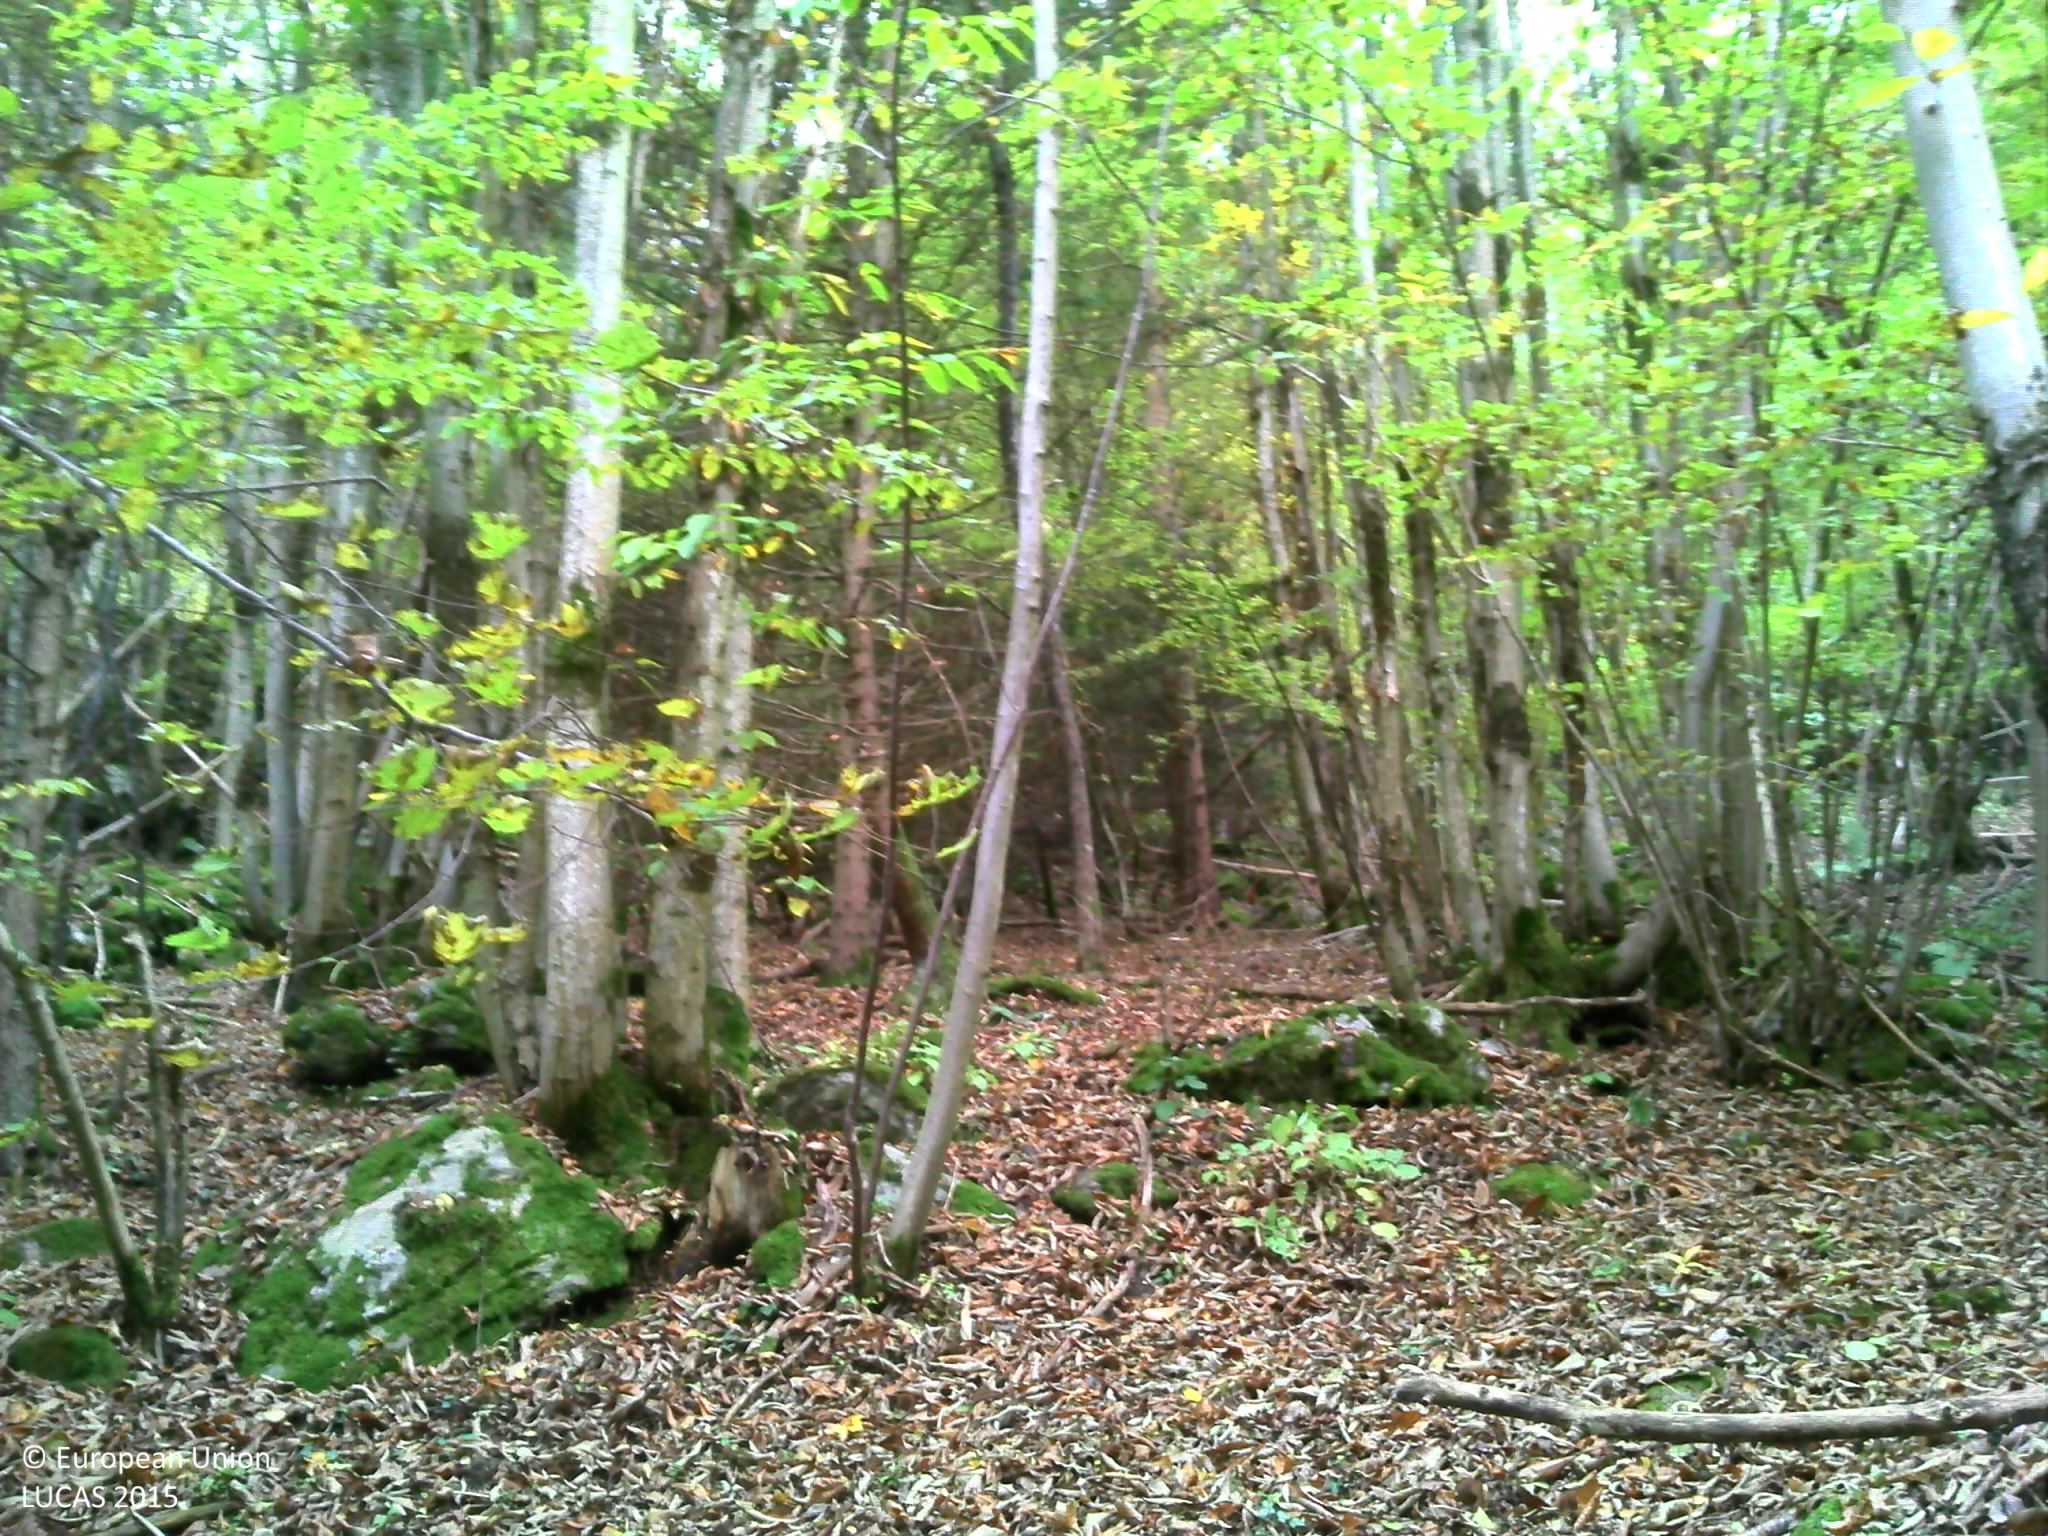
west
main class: Woodland
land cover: Broadleaved woodland
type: mesophytic deciduous forest
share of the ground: > 75 %
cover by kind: broadleaved forest trees 75 %, coniferous forest trees 15 %, unconsolidated bare surface 10 %
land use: Forestry
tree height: > 5 m
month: October
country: FR
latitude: 45.4202
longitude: 6.2604
